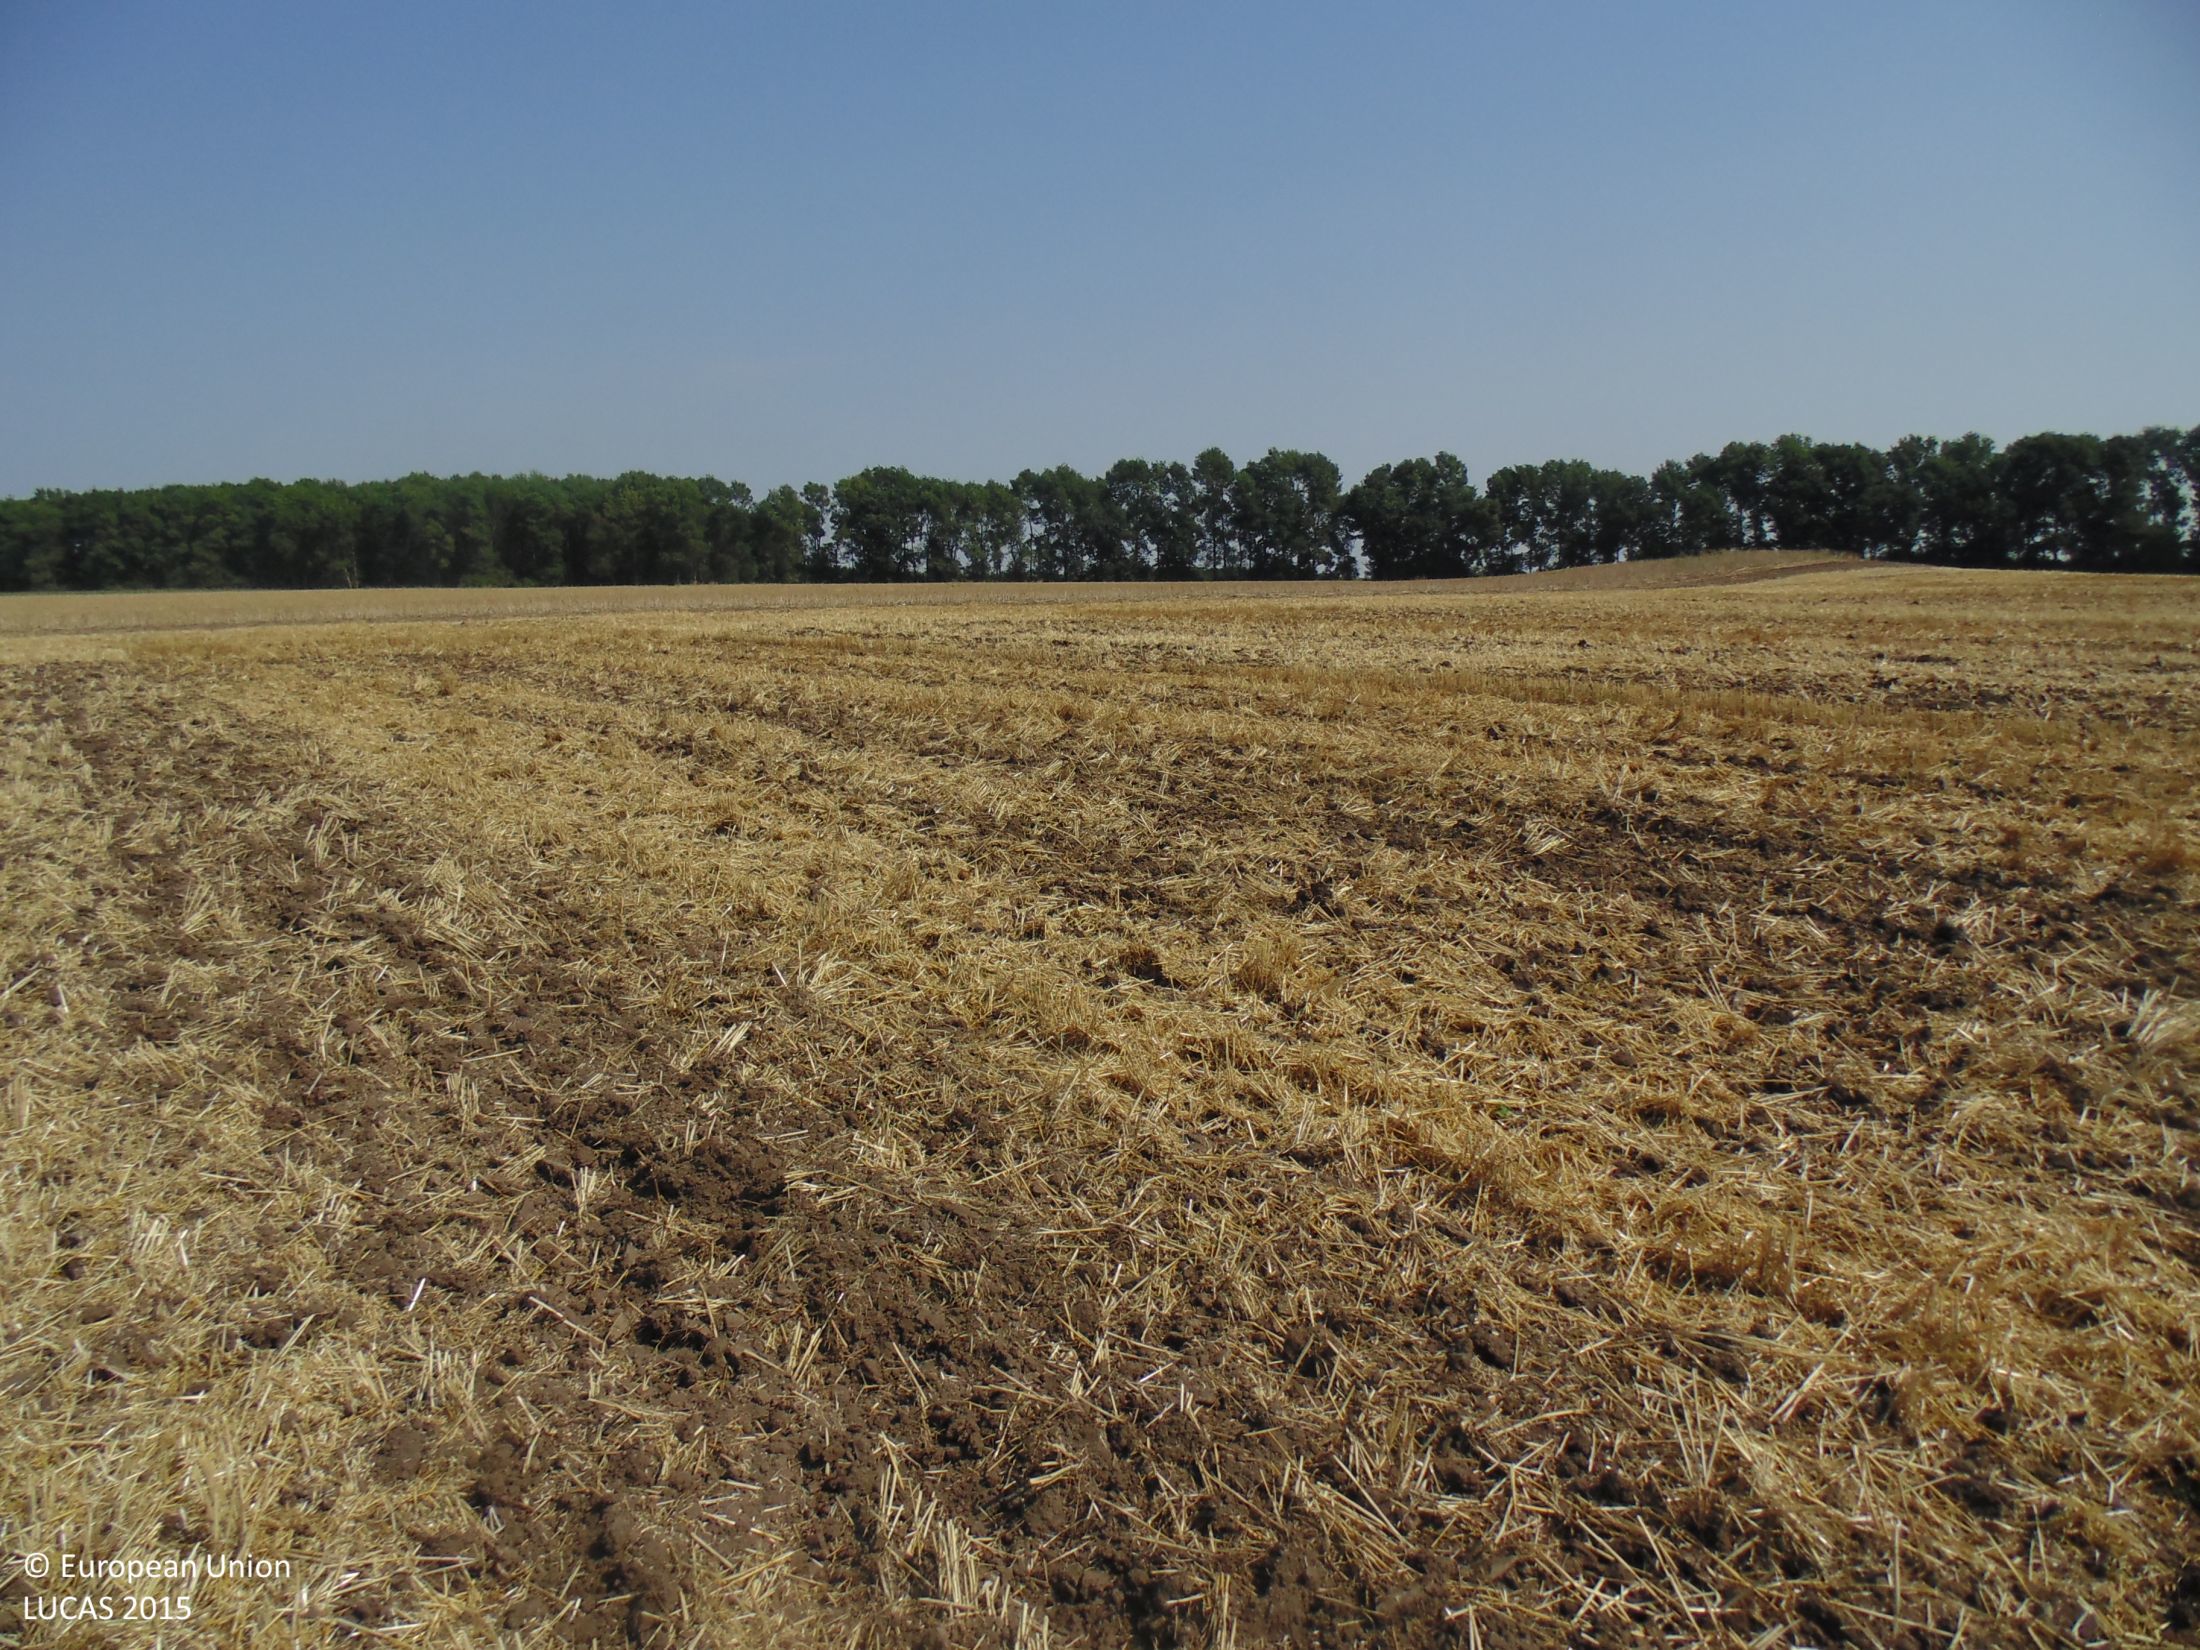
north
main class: Cropland
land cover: Common wheat
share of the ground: 10 - 25 %
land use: Agriculture (excluding fallow land and kitchen gardens)
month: July
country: BG
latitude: 43.5084
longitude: 27.9433
